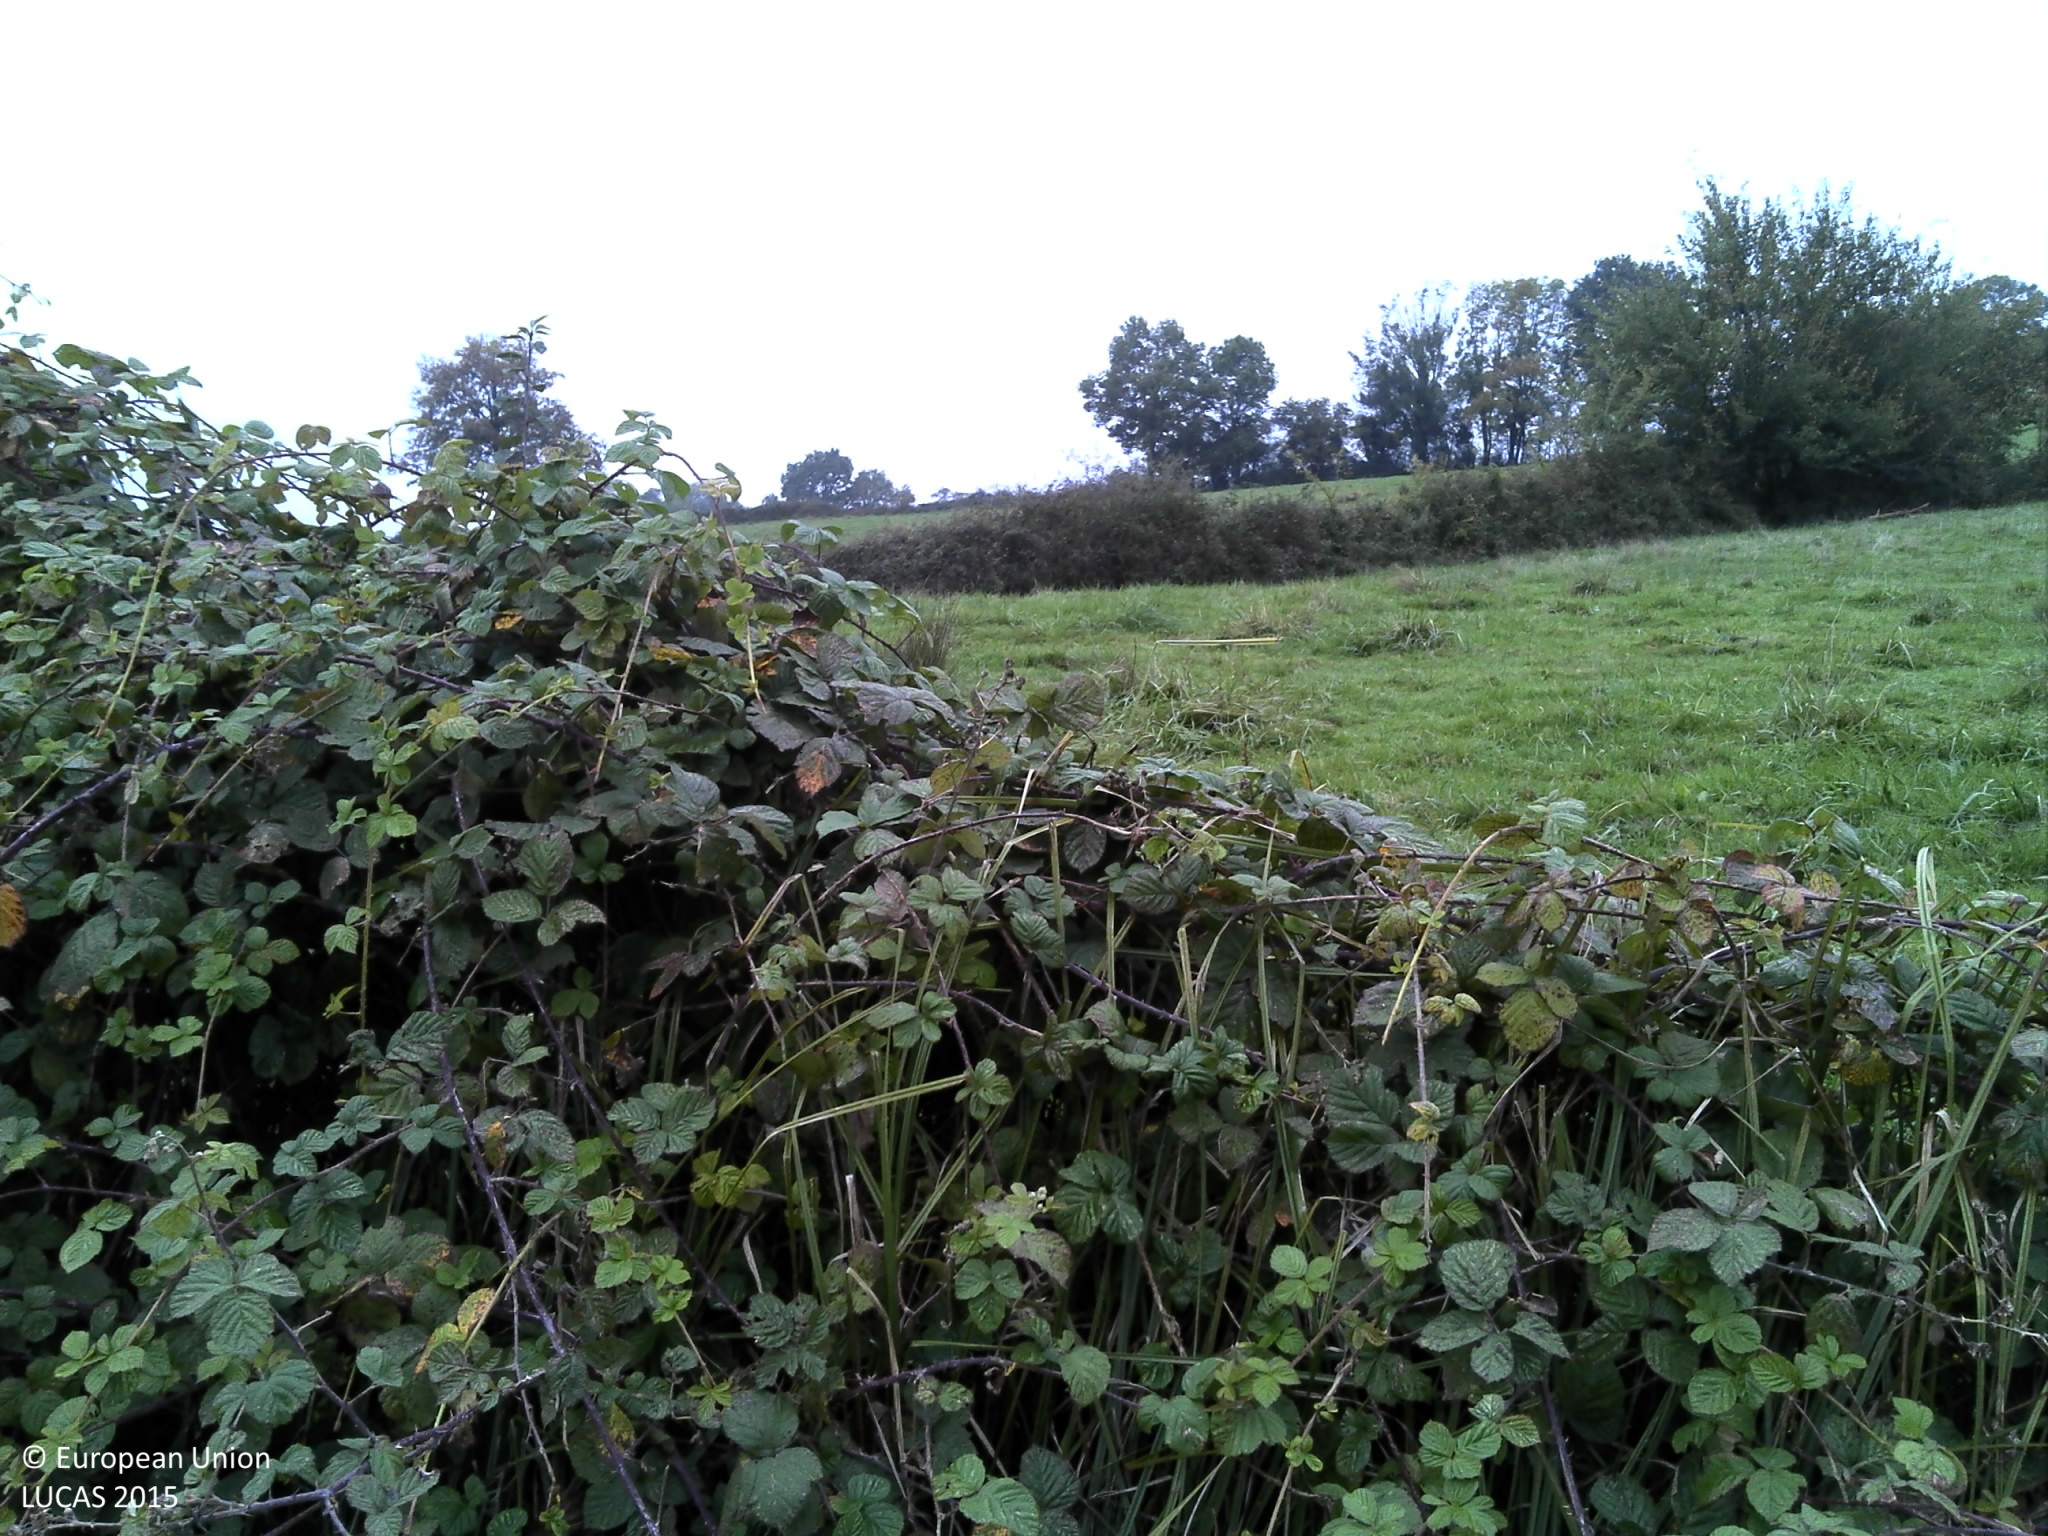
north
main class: Grassland
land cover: Grassland without tree/shrub cover
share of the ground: > 75 %
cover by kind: herbaceous plants 100 %
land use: Agriculture (excluding fallow land and kitchen gardens)
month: October
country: FR
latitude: 46.3746
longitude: 5.3096
